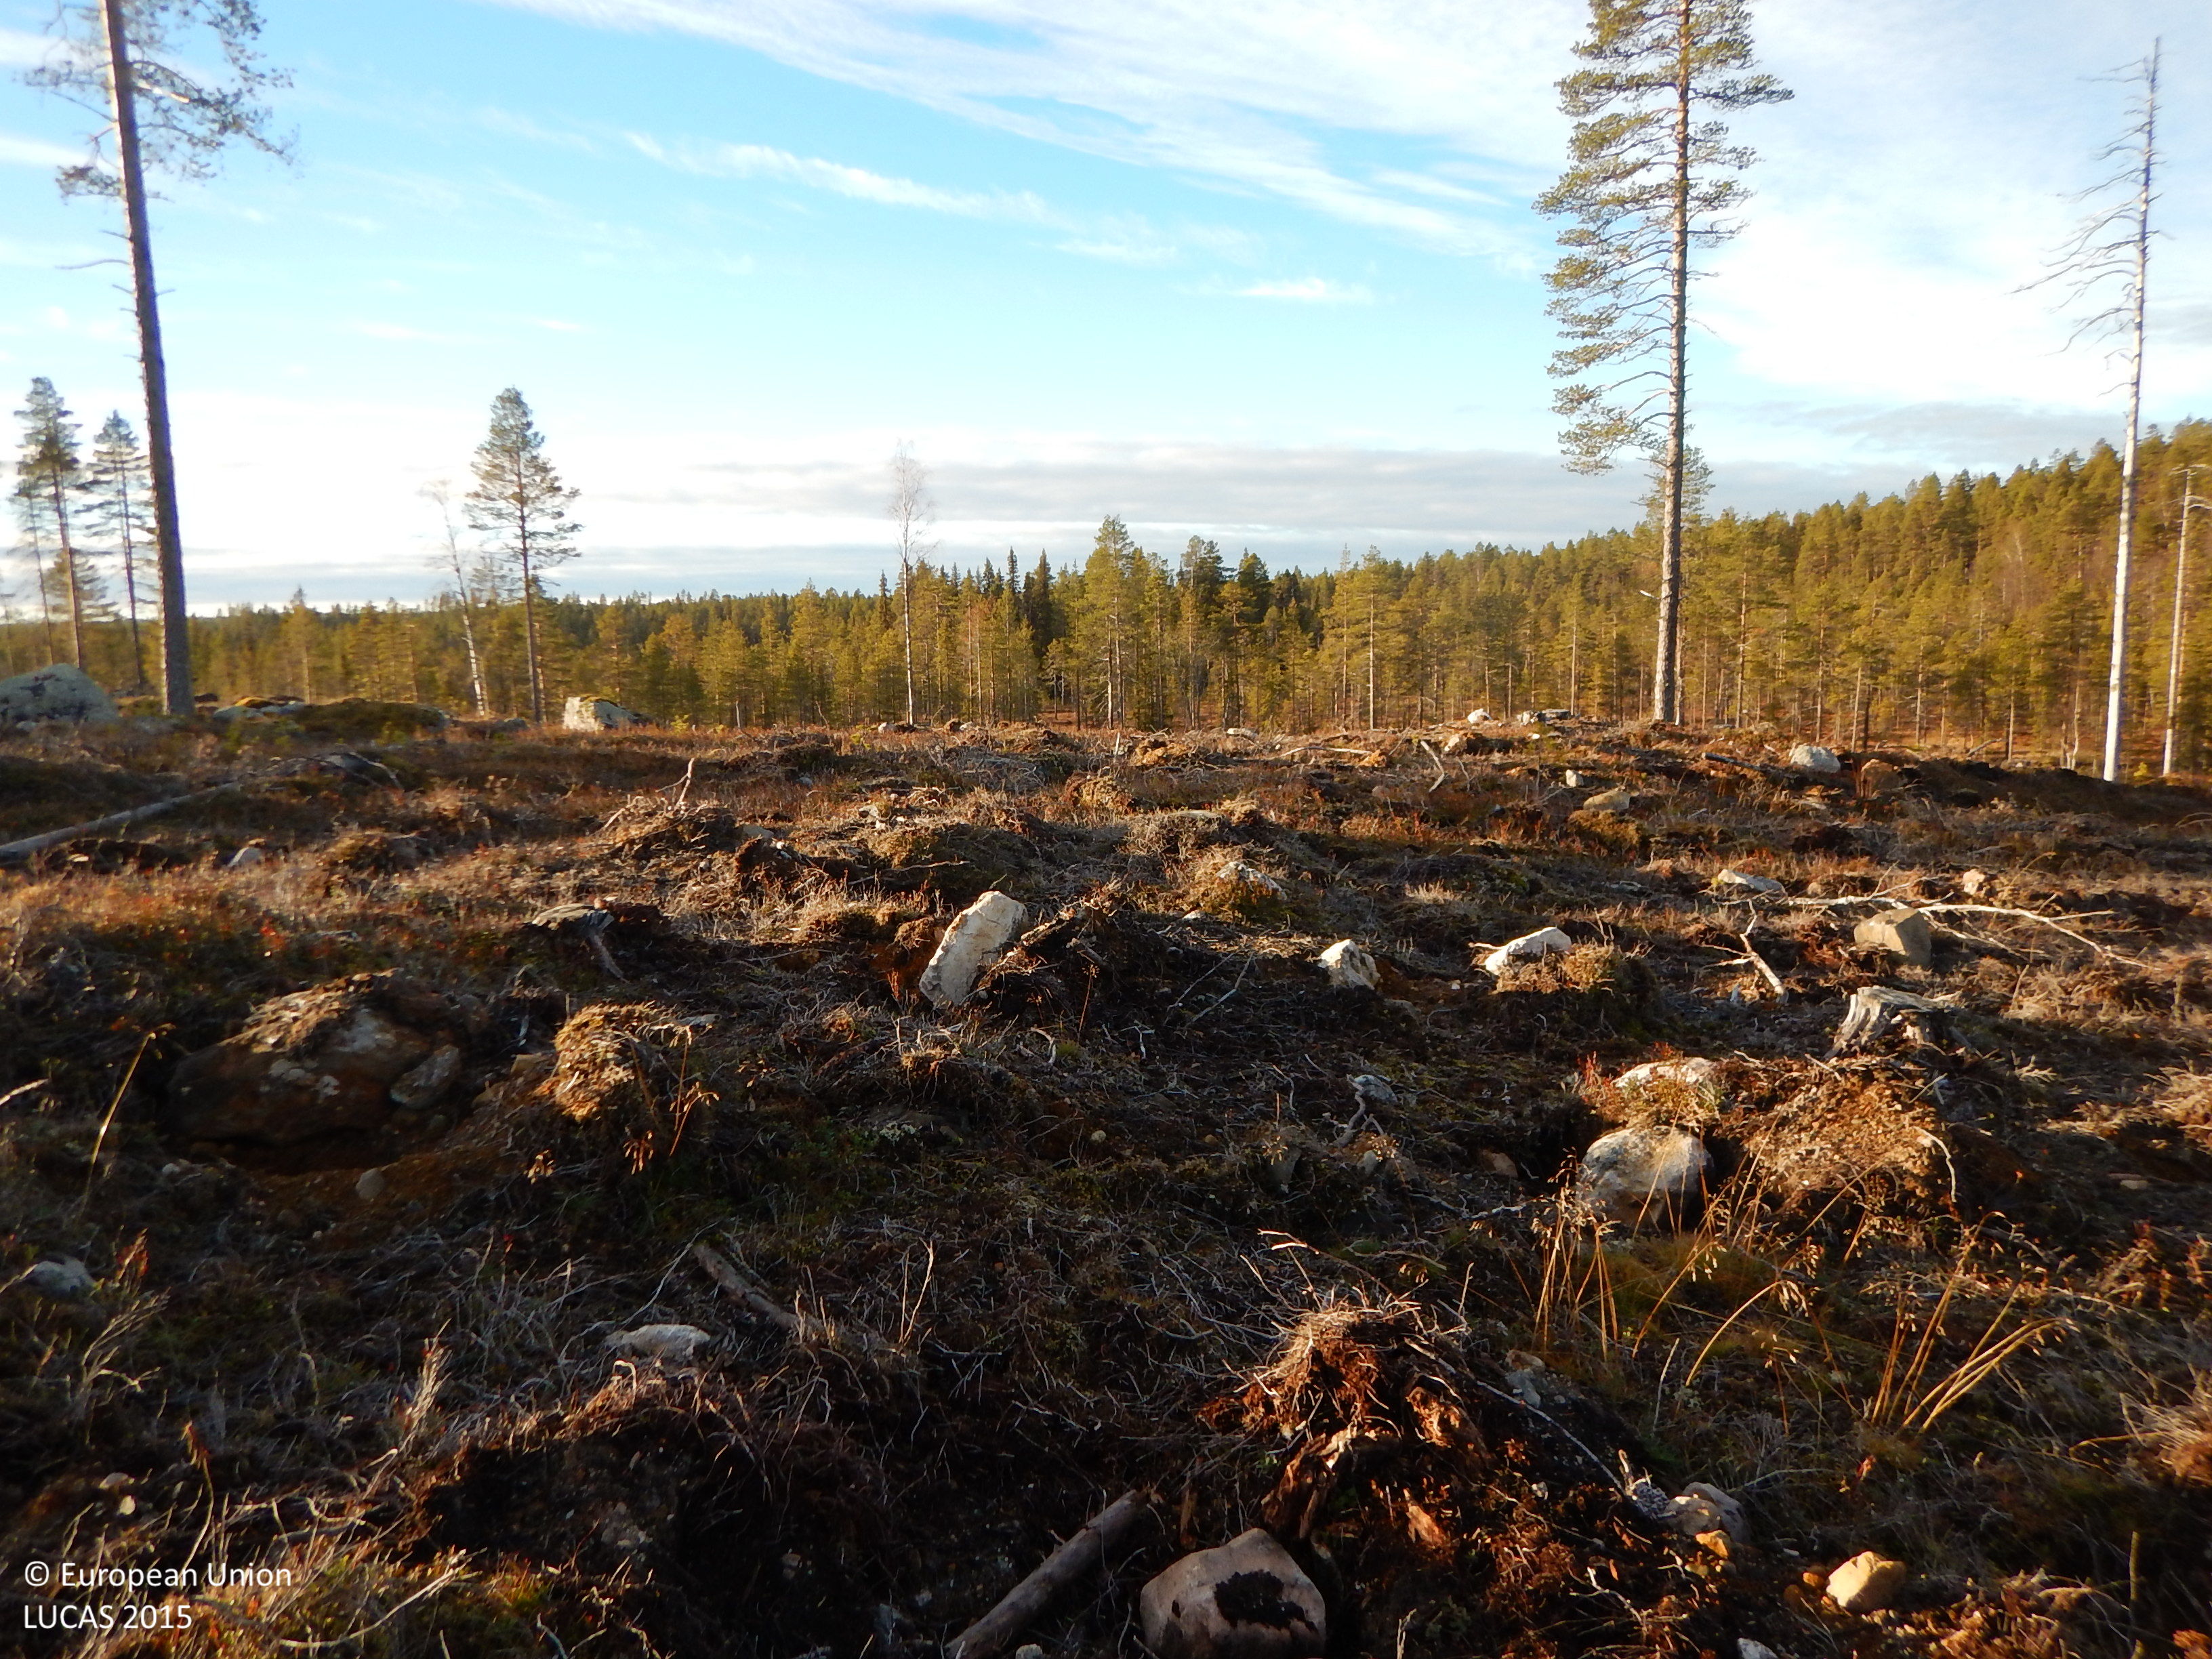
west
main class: Shrubland
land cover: Shrubland with sparse tree cover
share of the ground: 50 - 75 %
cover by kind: shrubs 50 %, herbaceous plants 20 %, lichens and mosses 15 %, coniferous forest trees 5 %, consolidated bare surface 5 %, unconsolidated bare surface 5 %
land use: Forestry
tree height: < 5 m
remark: Clear cut
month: November
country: SE
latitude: 65.3389
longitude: 20.6015
